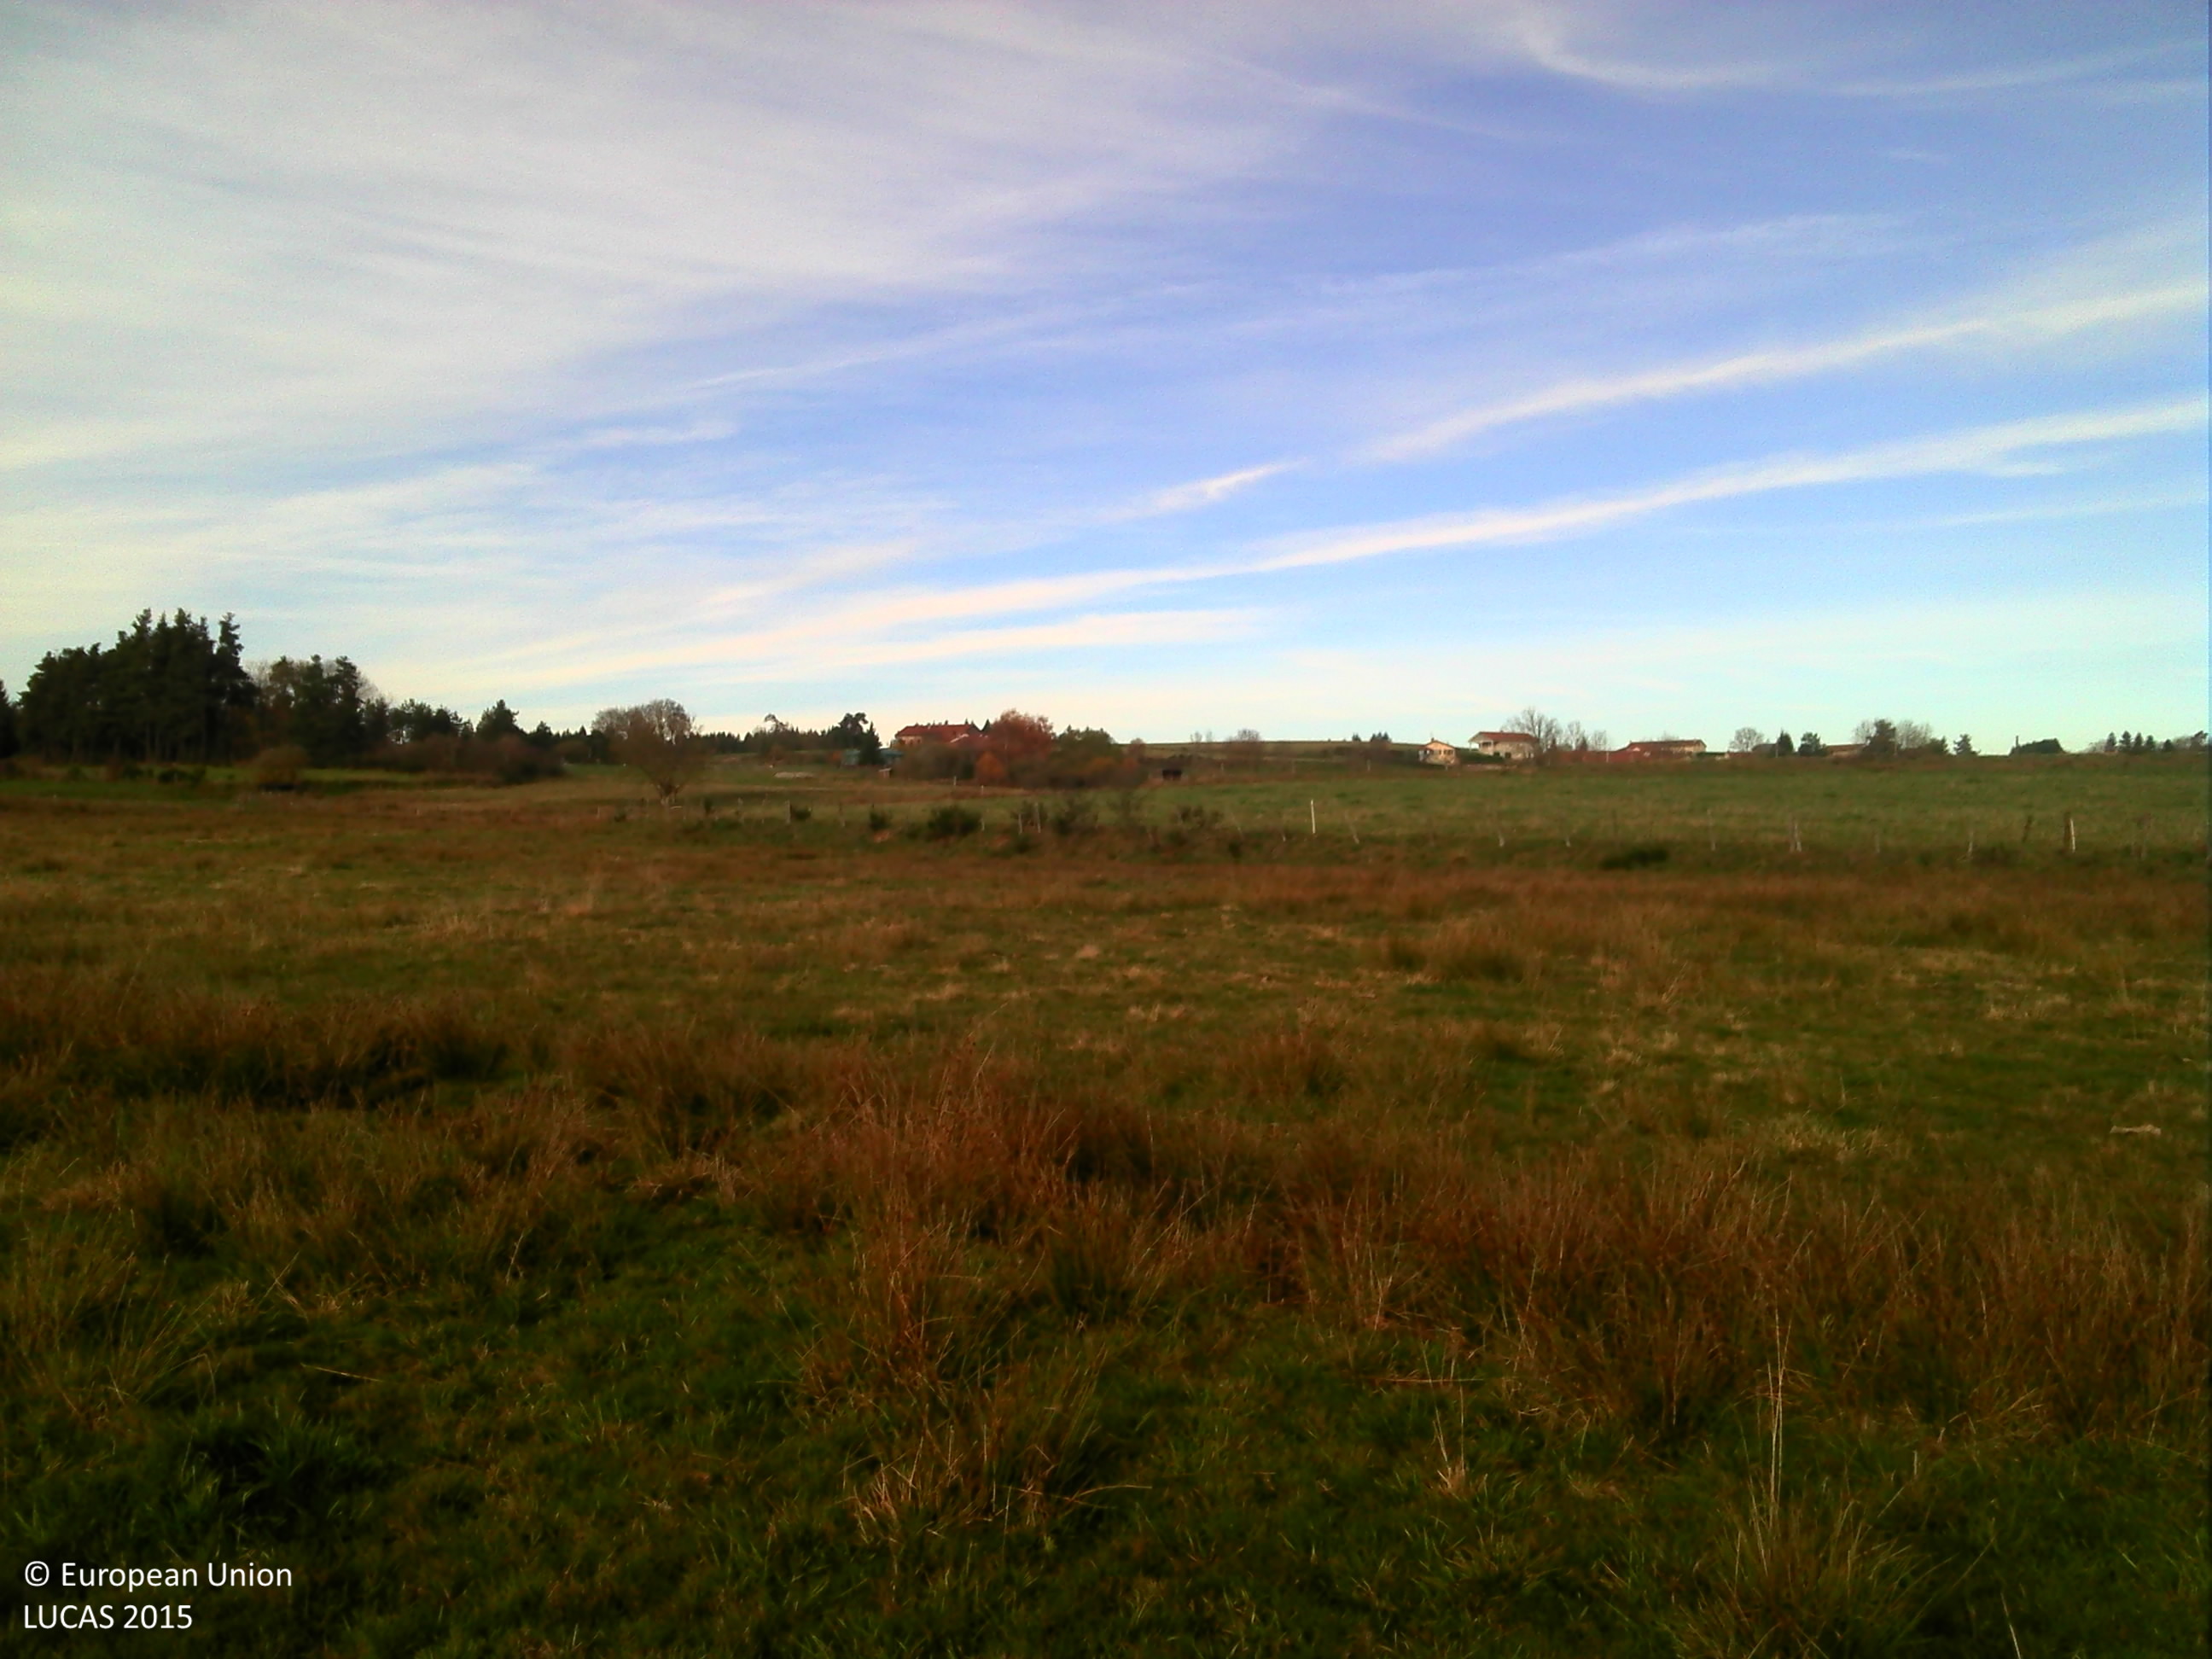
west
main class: Grassland
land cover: Grassland without tree/shrub cover
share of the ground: > 75 %
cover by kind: herbaceous plants 100 %
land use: Agriculture (excluding fallow land and kitchen gardens)
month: November
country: FR
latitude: 45.3216
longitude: 3.7902
